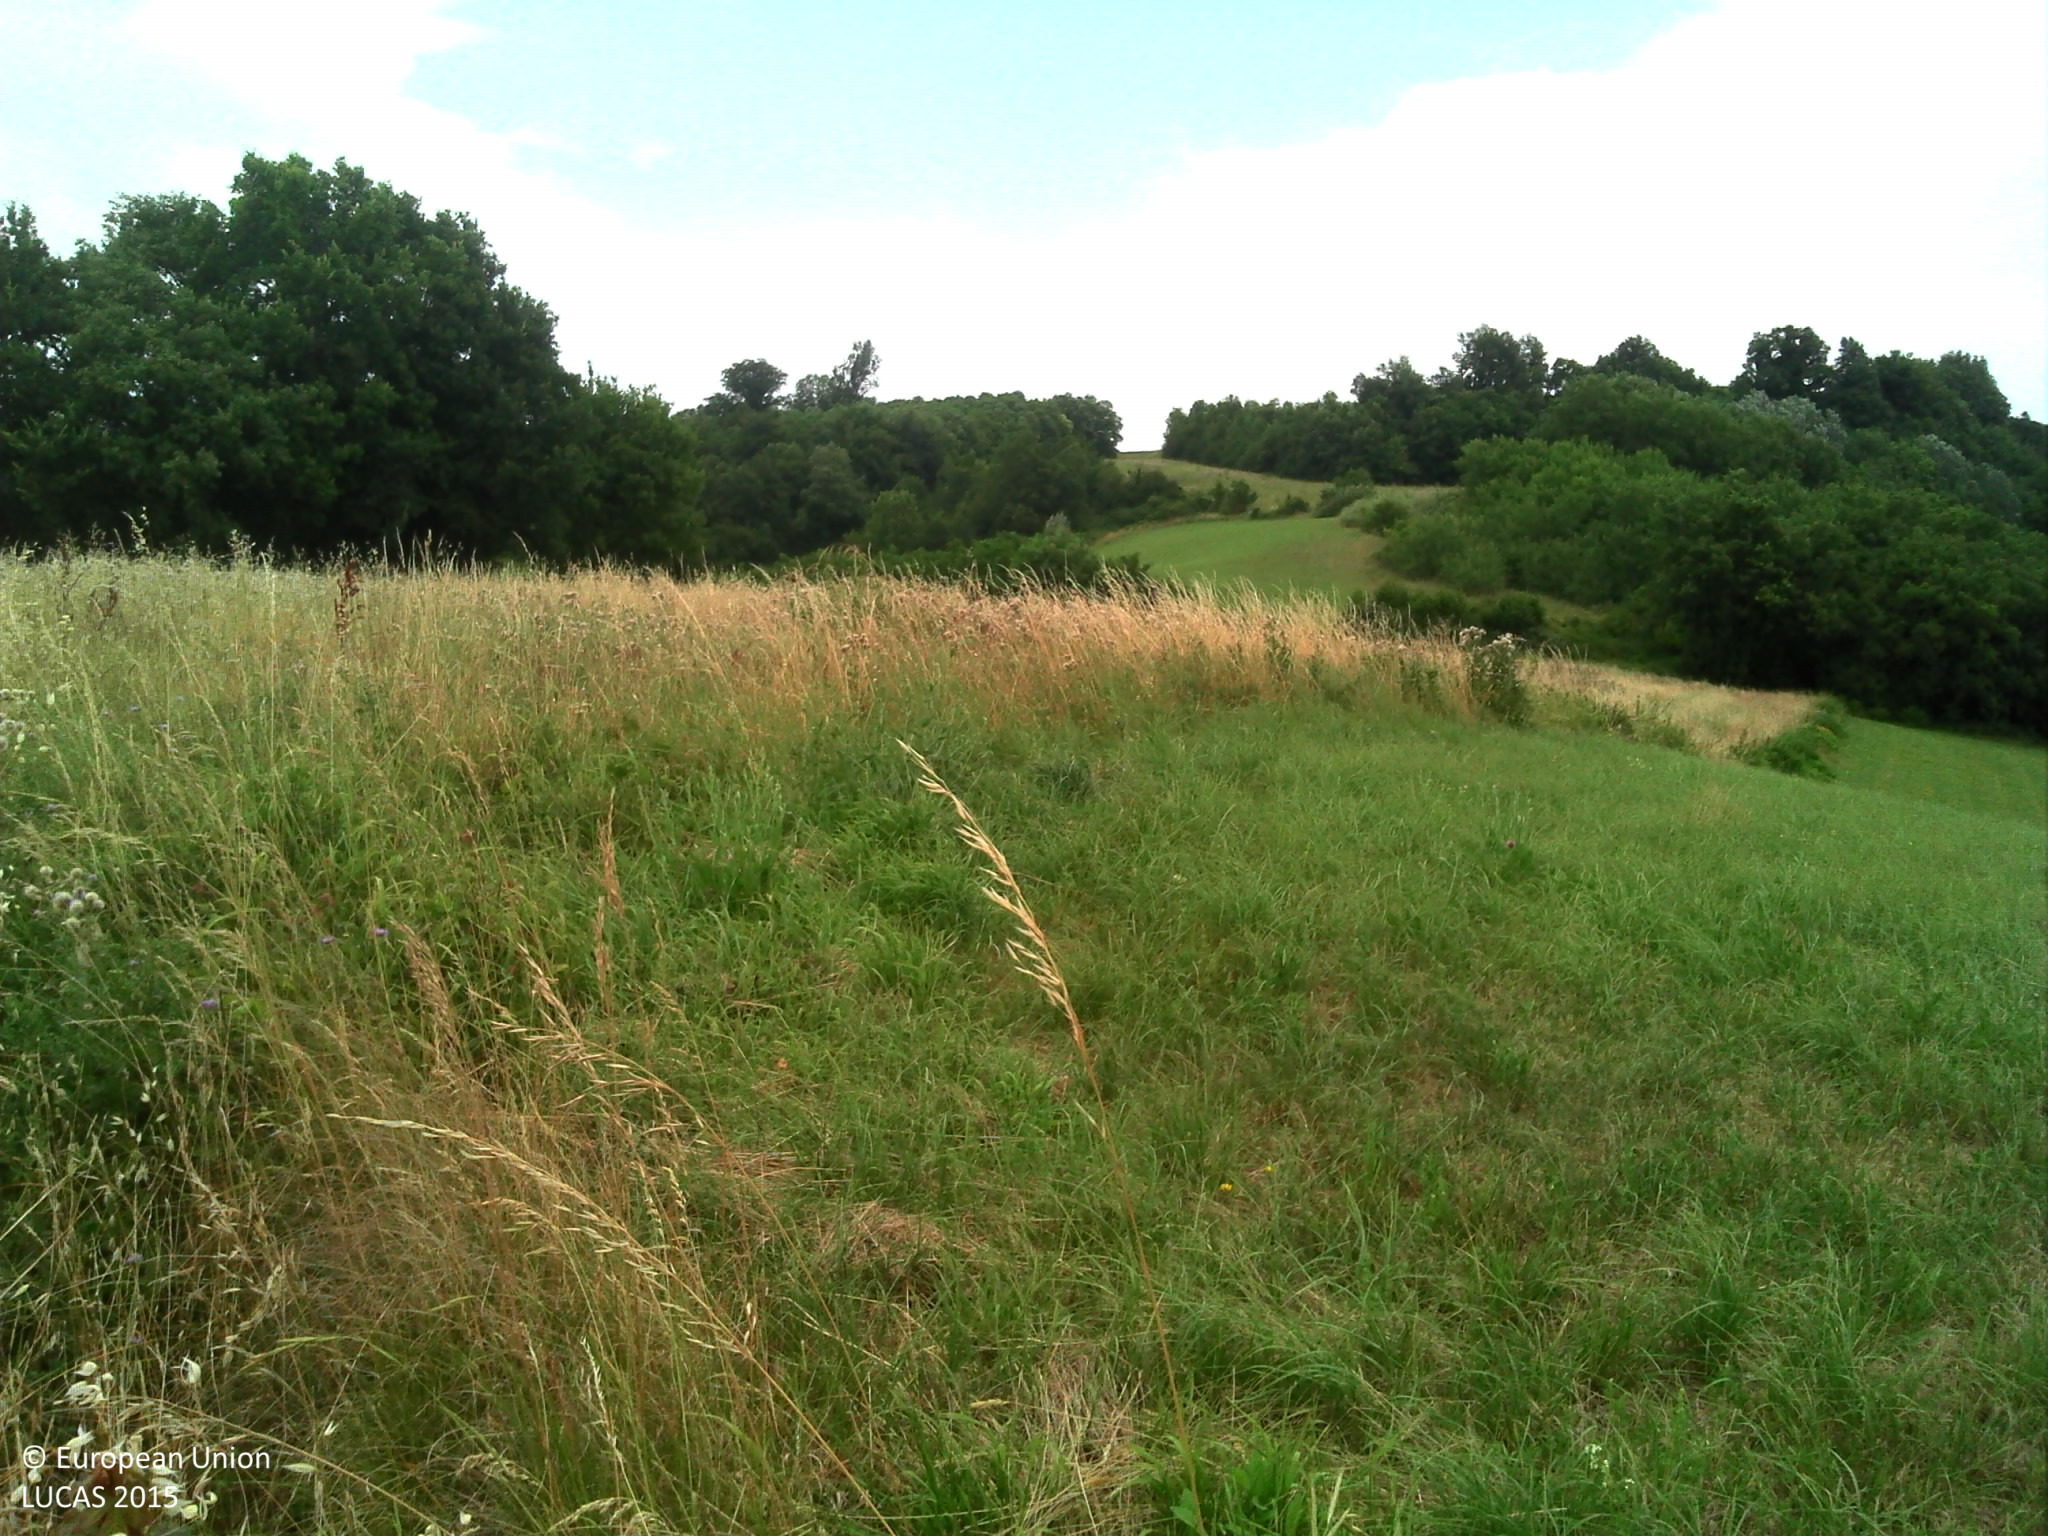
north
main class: Cropland
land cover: Mixed cereals for fodder
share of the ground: > 75 %
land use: Agriculture (excluding fallow land and kitchen gardens)
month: July
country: FR
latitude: 45.2235
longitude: 5.0000
